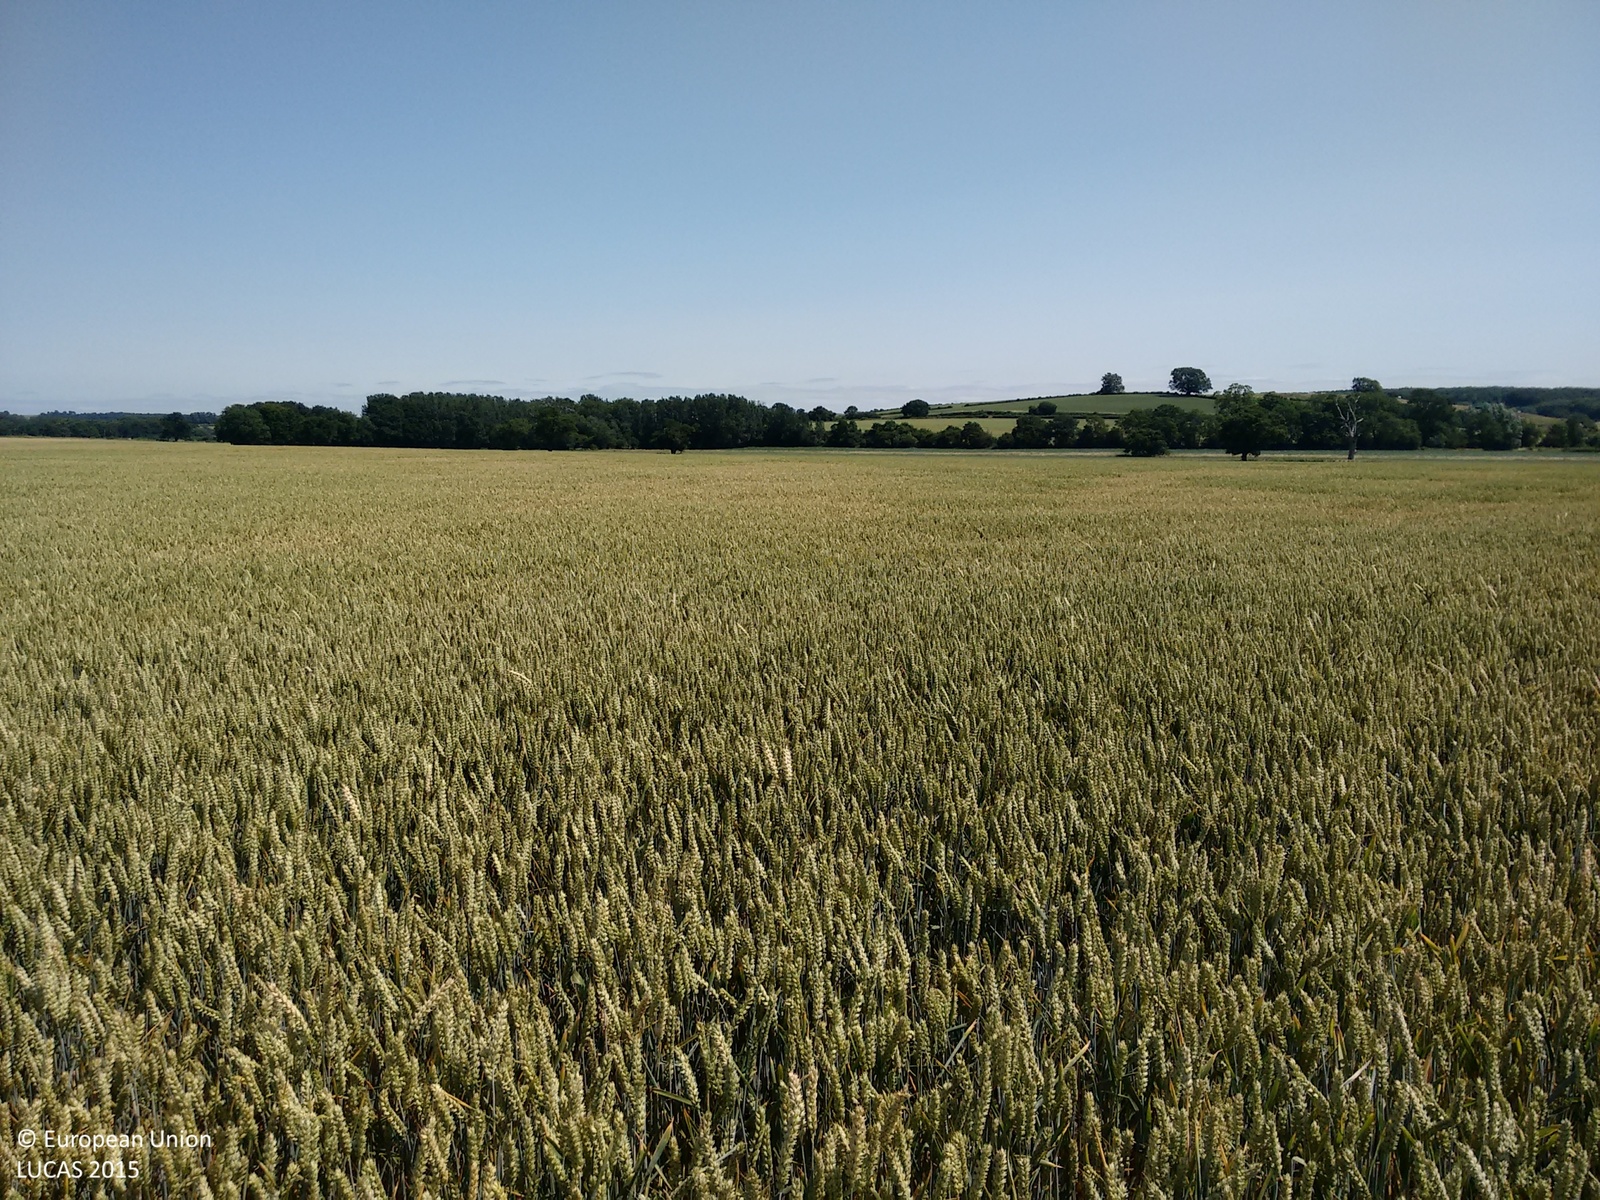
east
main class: Cropland
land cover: Common wheat
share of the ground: > 75 %
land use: Agriculture (excluding fallow land and kitchen gardens)
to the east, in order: Common wheat
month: July
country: GB
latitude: 53.2469
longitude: -0.9682
